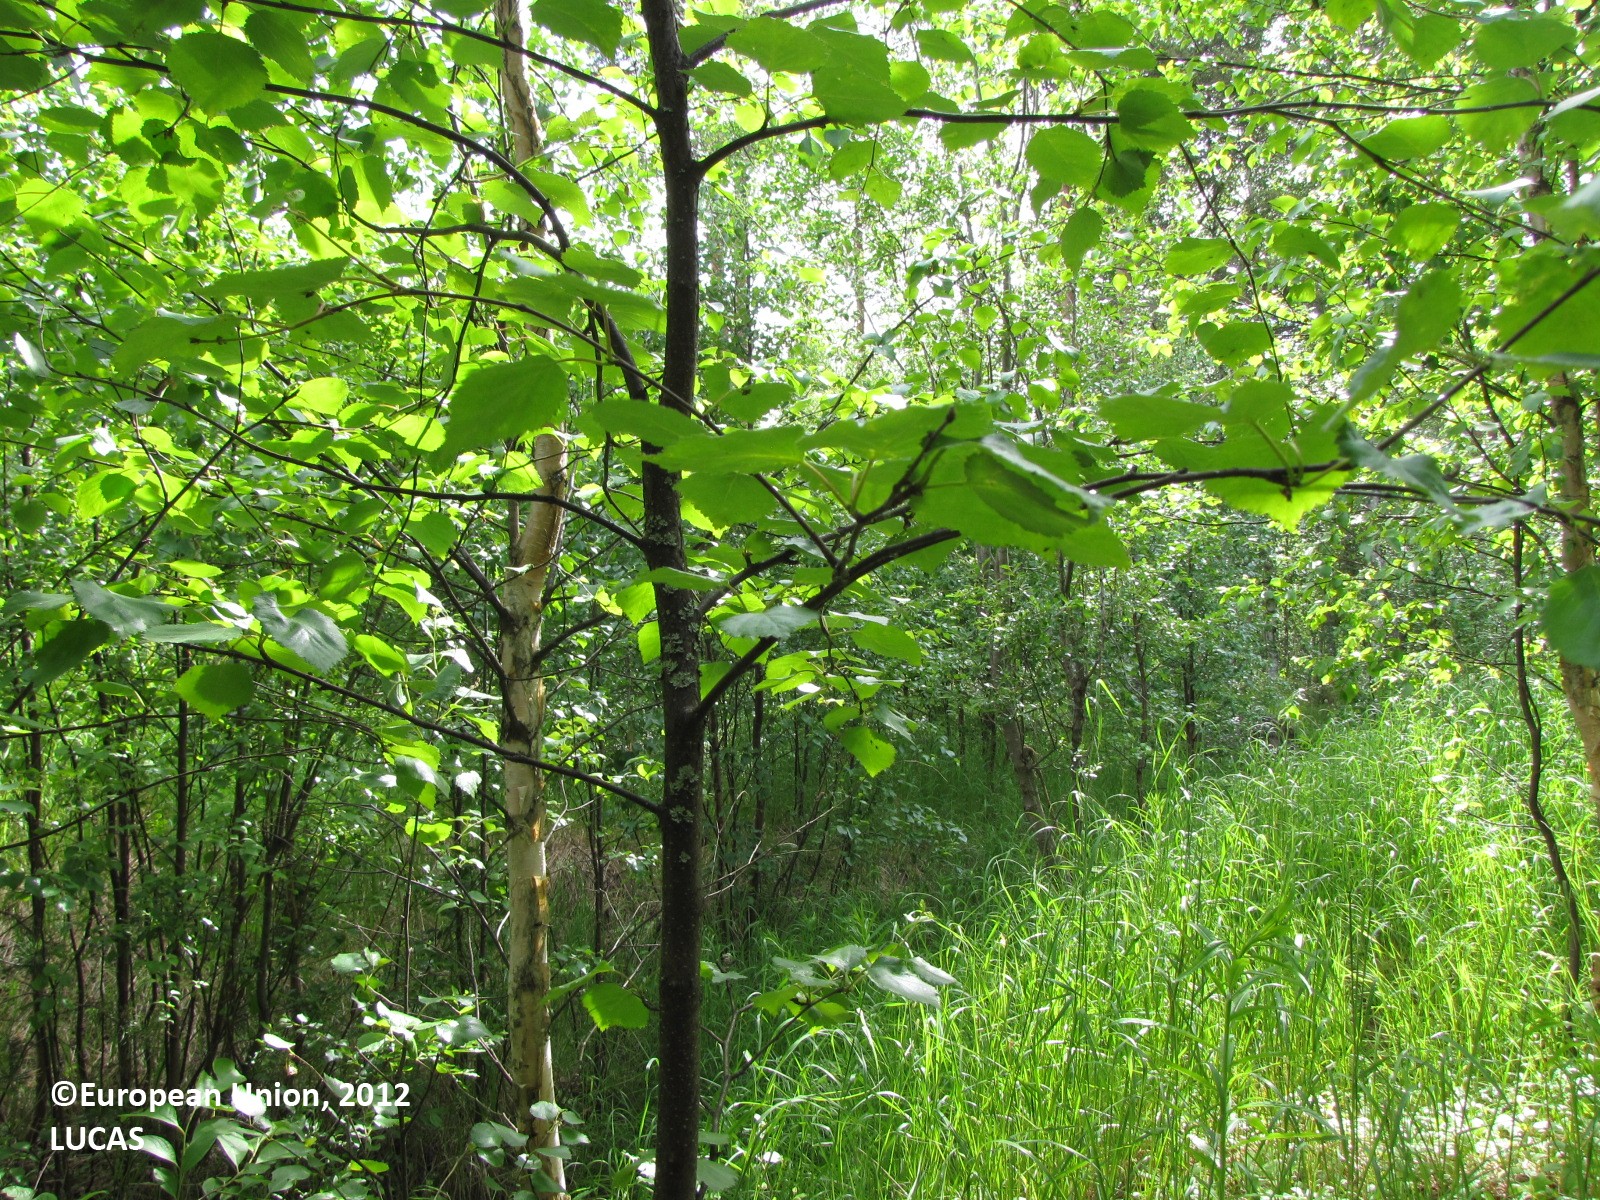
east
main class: Woodland
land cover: Broadleaved woodland
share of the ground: 50 - 75 %
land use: Forestry
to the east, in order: Broadleaved woodland; Ditches and canals; Broadleaved woodland; Ditches and canals; Pine dominated mixed woodland; Ditches and canals; Lines of trees; Tracks; Lines of trees; Ditches and canals; Pine dominated mixed woodland; Ditches and canals; Pine dominated mixed woodland; Ditches and canals; Pine dominated mixed woodland; Tracks; Pine dominated mixed woodland; Ditches and canals; Pine dominated mixed woodland
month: July
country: FI
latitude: 66.1420
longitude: 25.1502
